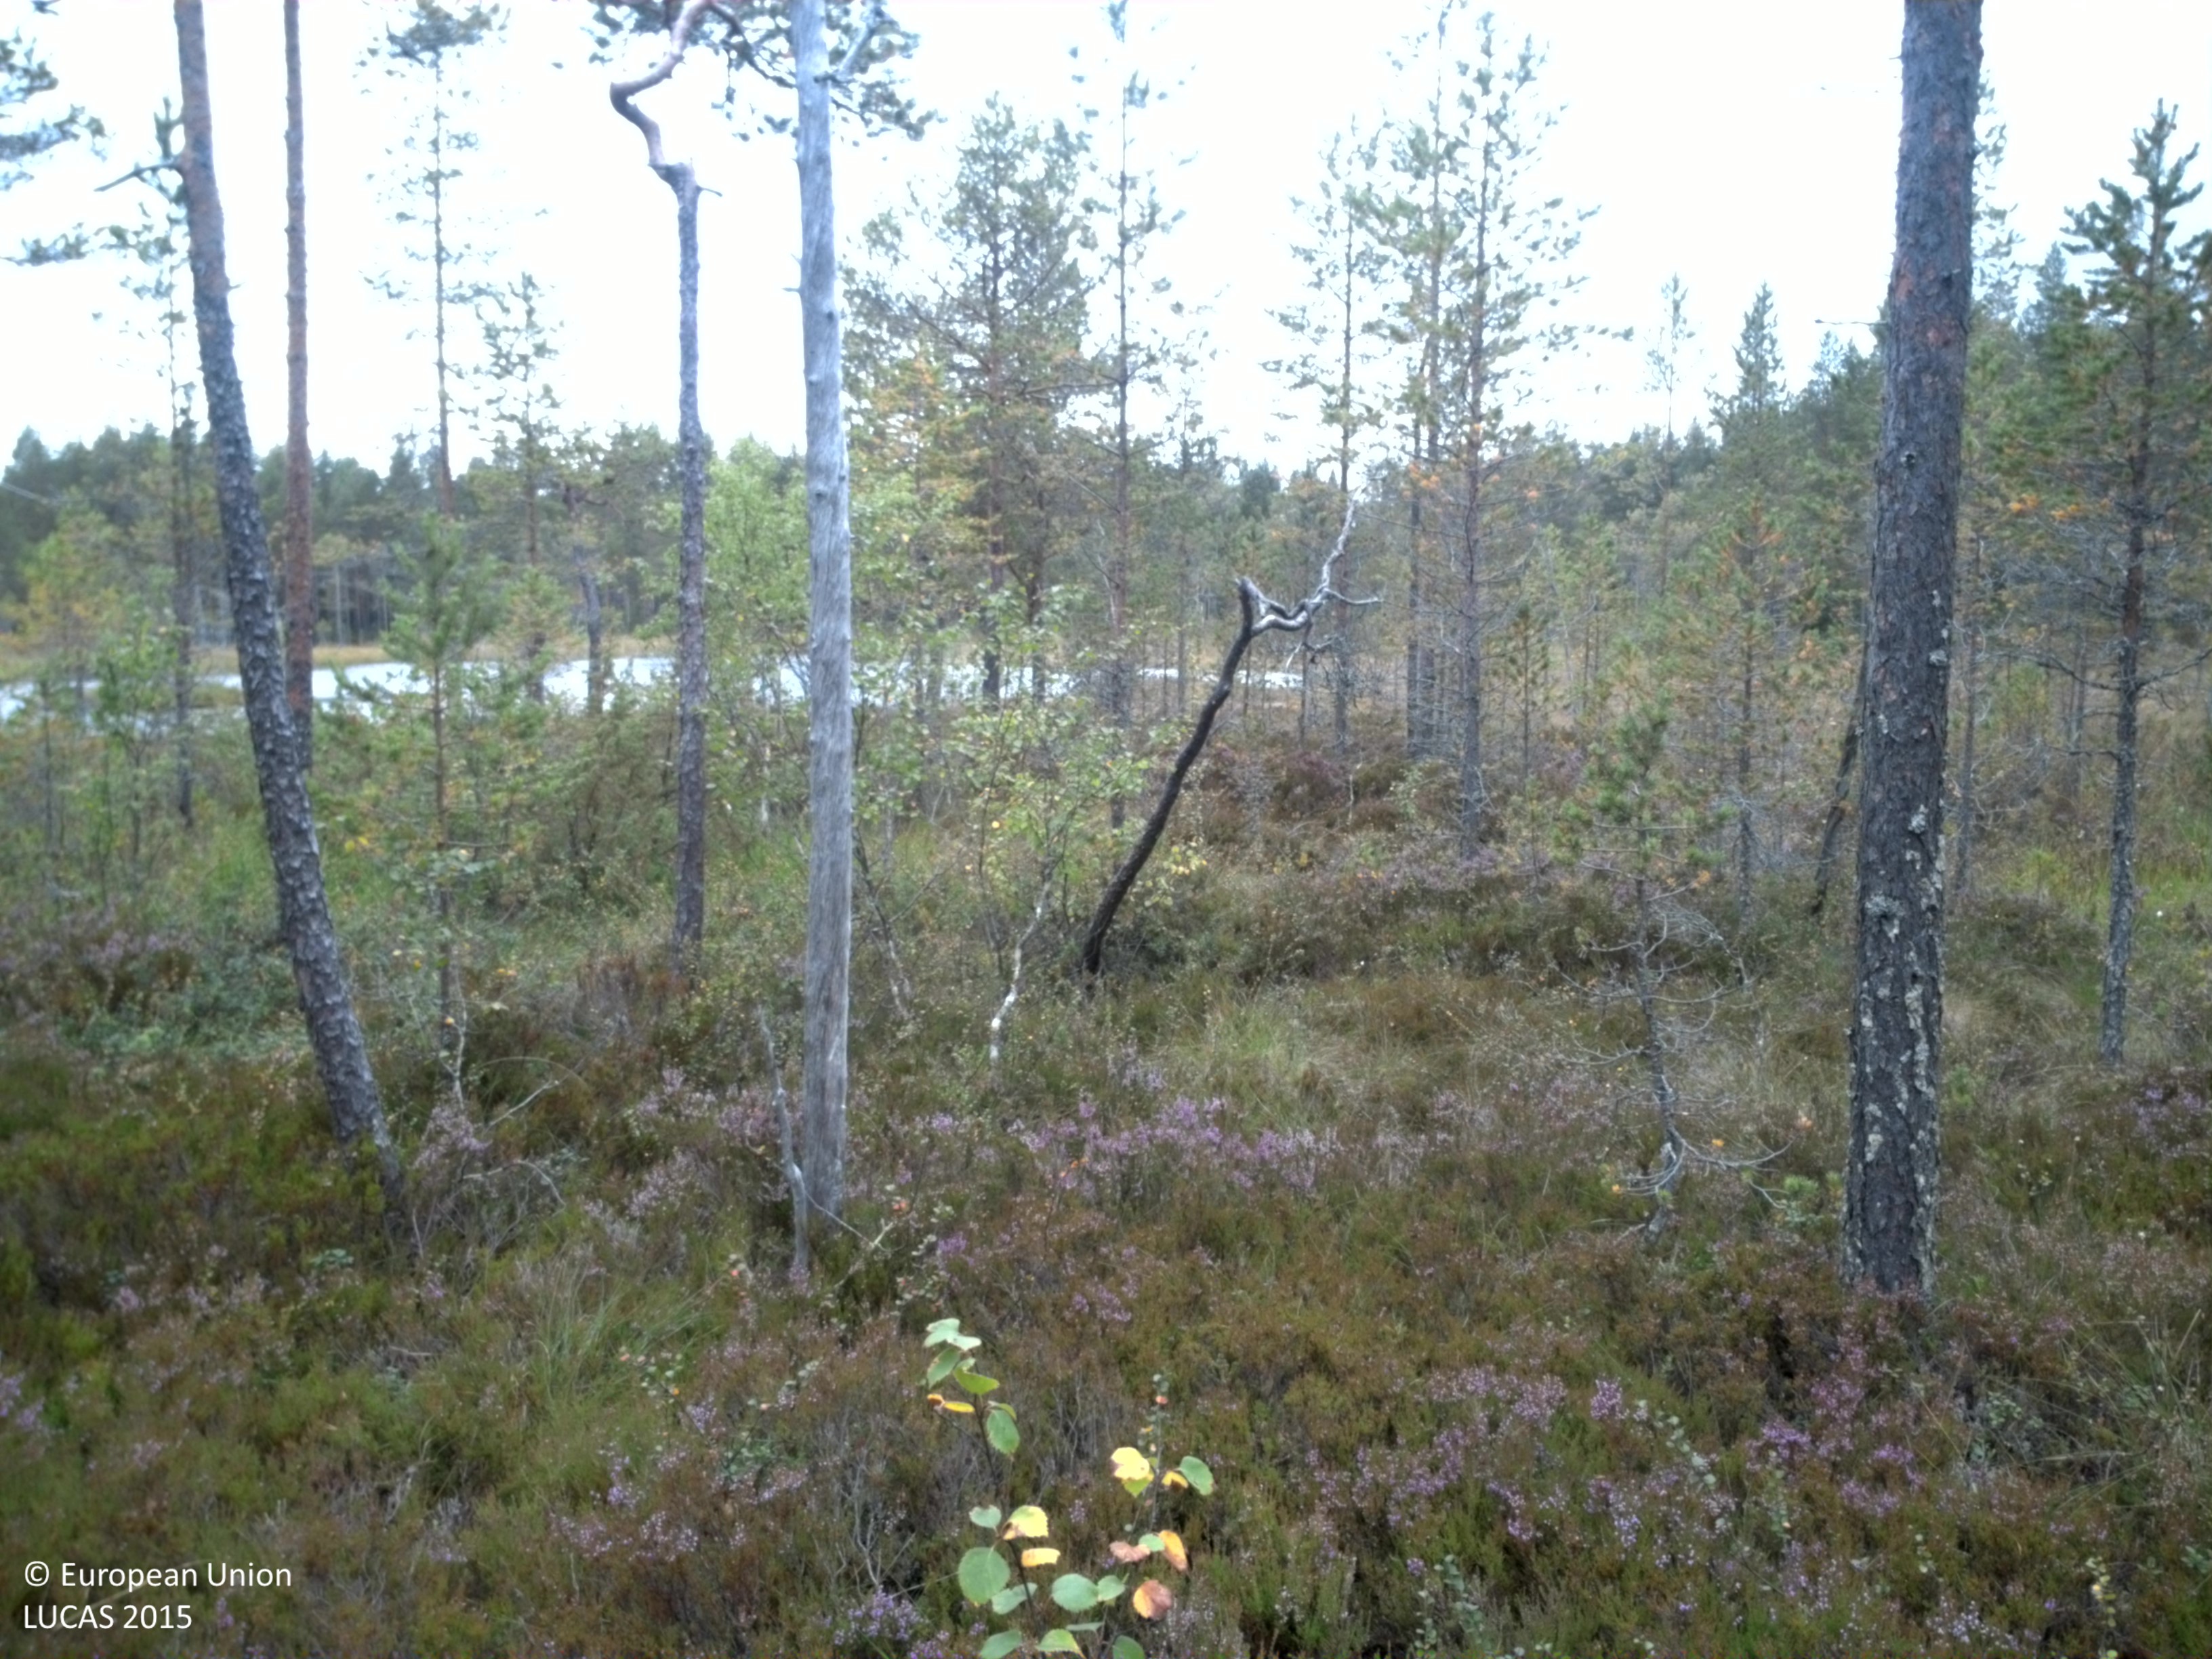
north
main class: Woodland
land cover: Pine dominated coniferous woodland
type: boreal forest
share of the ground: 25 - 50 %
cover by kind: coniferous forest trees 40 %, shrubs 40 %, lichens and mosses 15 %, broadleaved forest trees 5 %
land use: Forestry
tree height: > 5 m
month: August
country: SE
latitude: 61.6961
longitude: 15.0692
